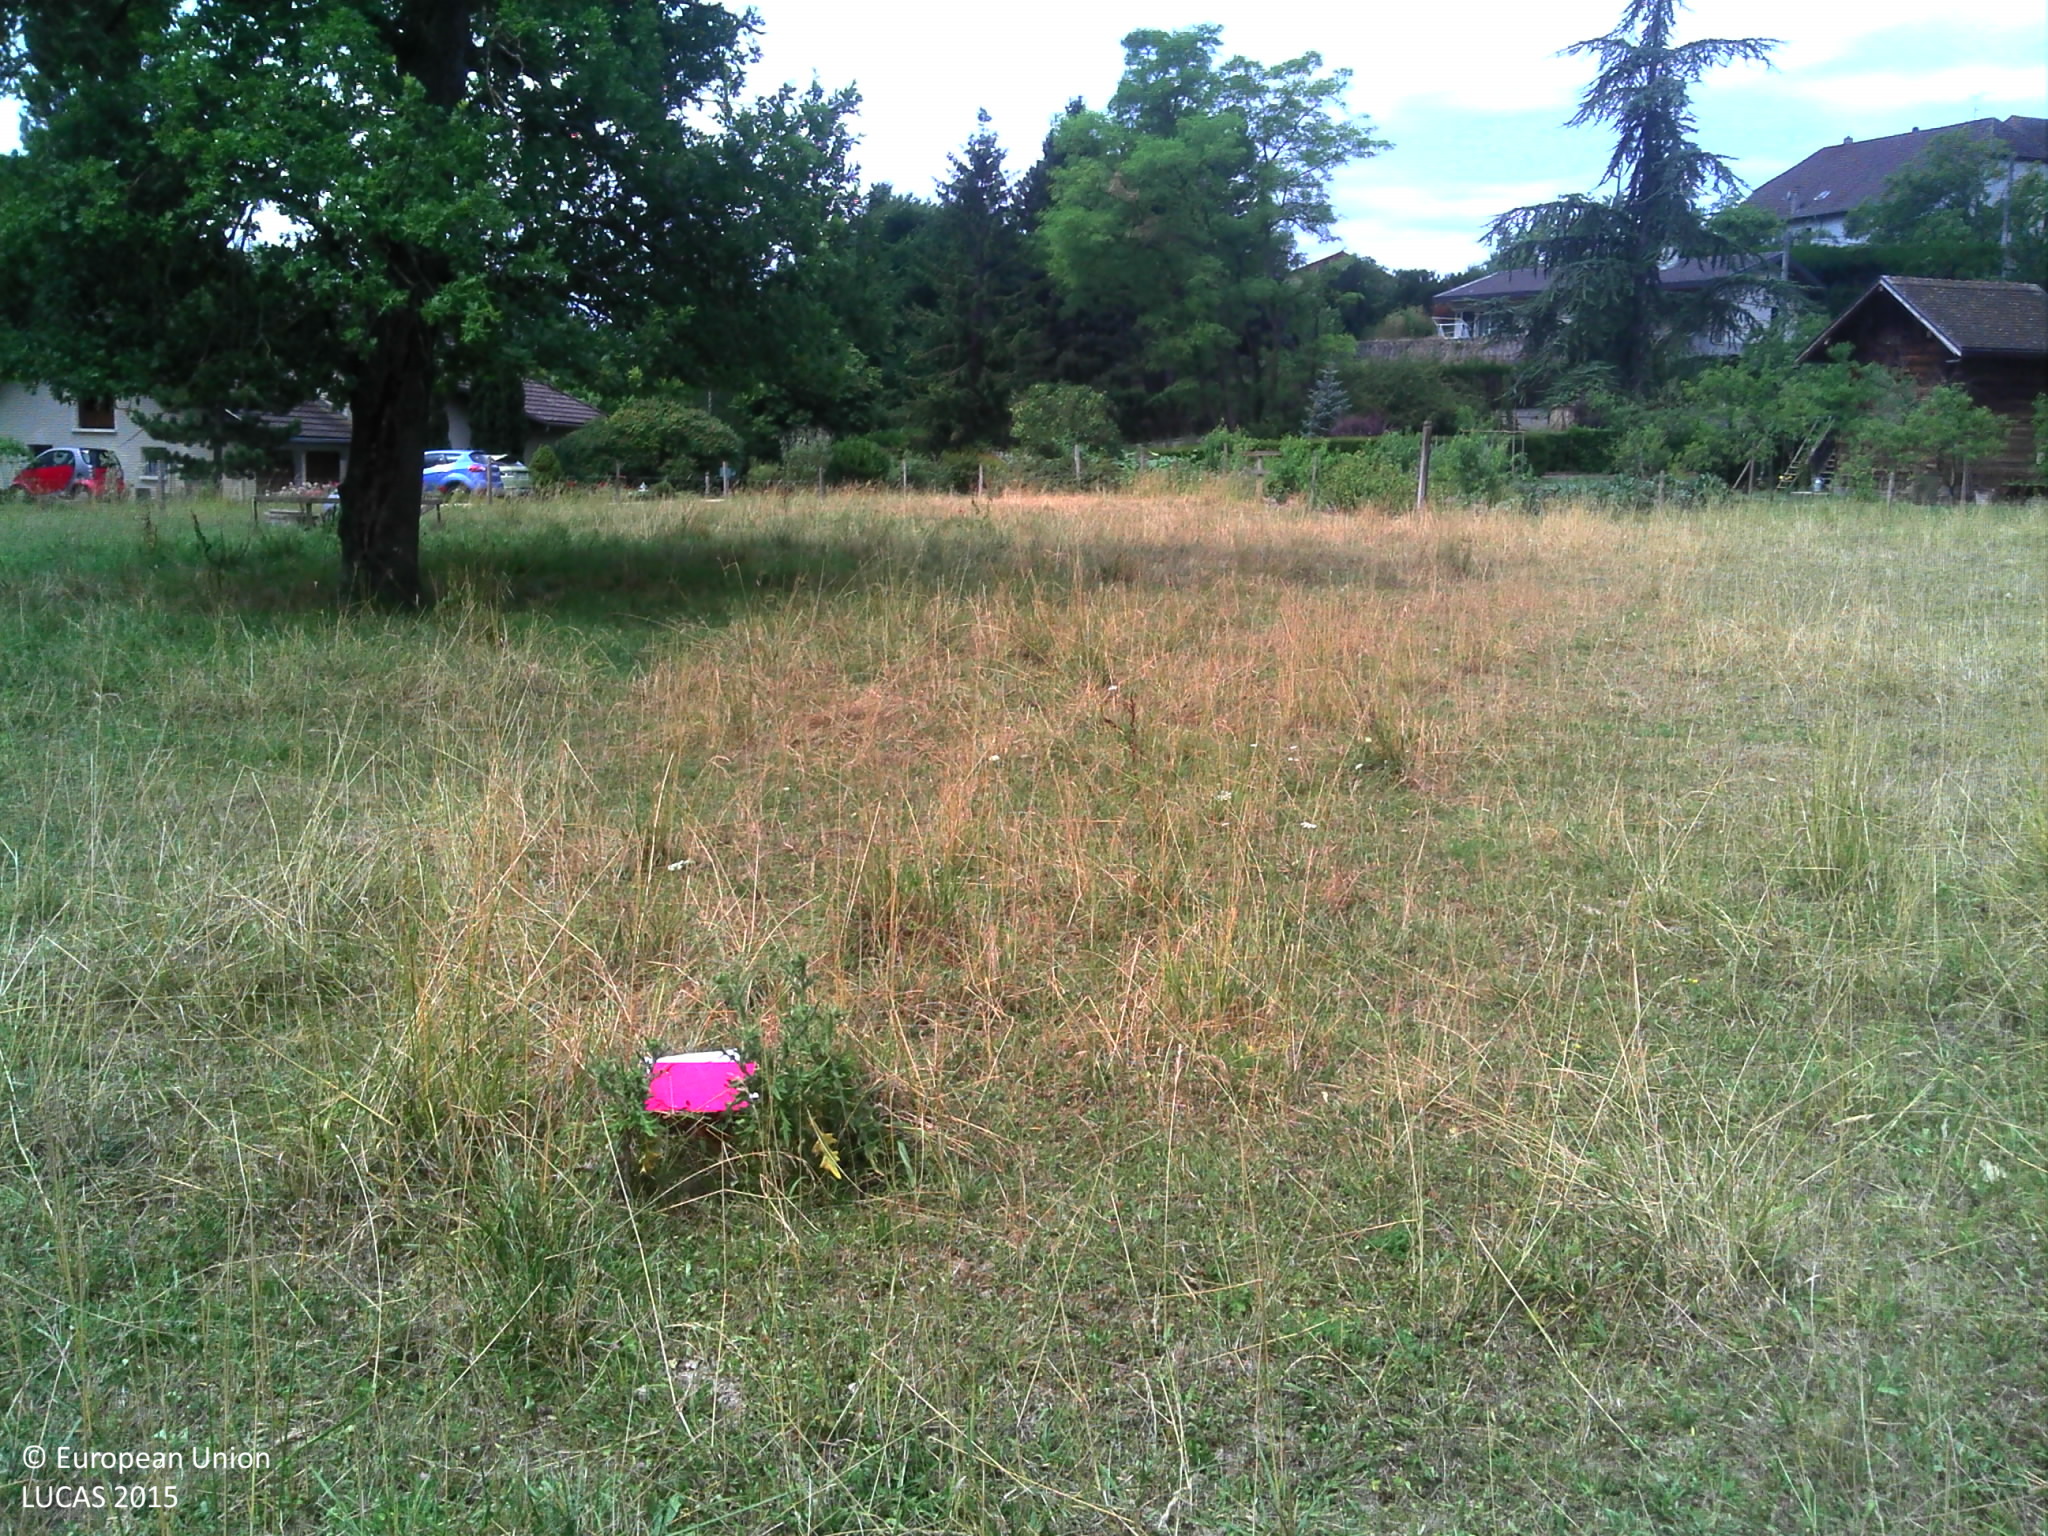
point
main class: Grassland
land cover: Grassland with sparse tree/shrub cover
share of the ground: > 75 %
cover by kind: herbaceous plants 95 %, broadleaved forest trees 5 %
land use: Agriculture (excluding fallow land and kitchen gardens)
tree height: > 5 m
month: July
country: FR
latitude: 46.2145
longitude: 6.2832
